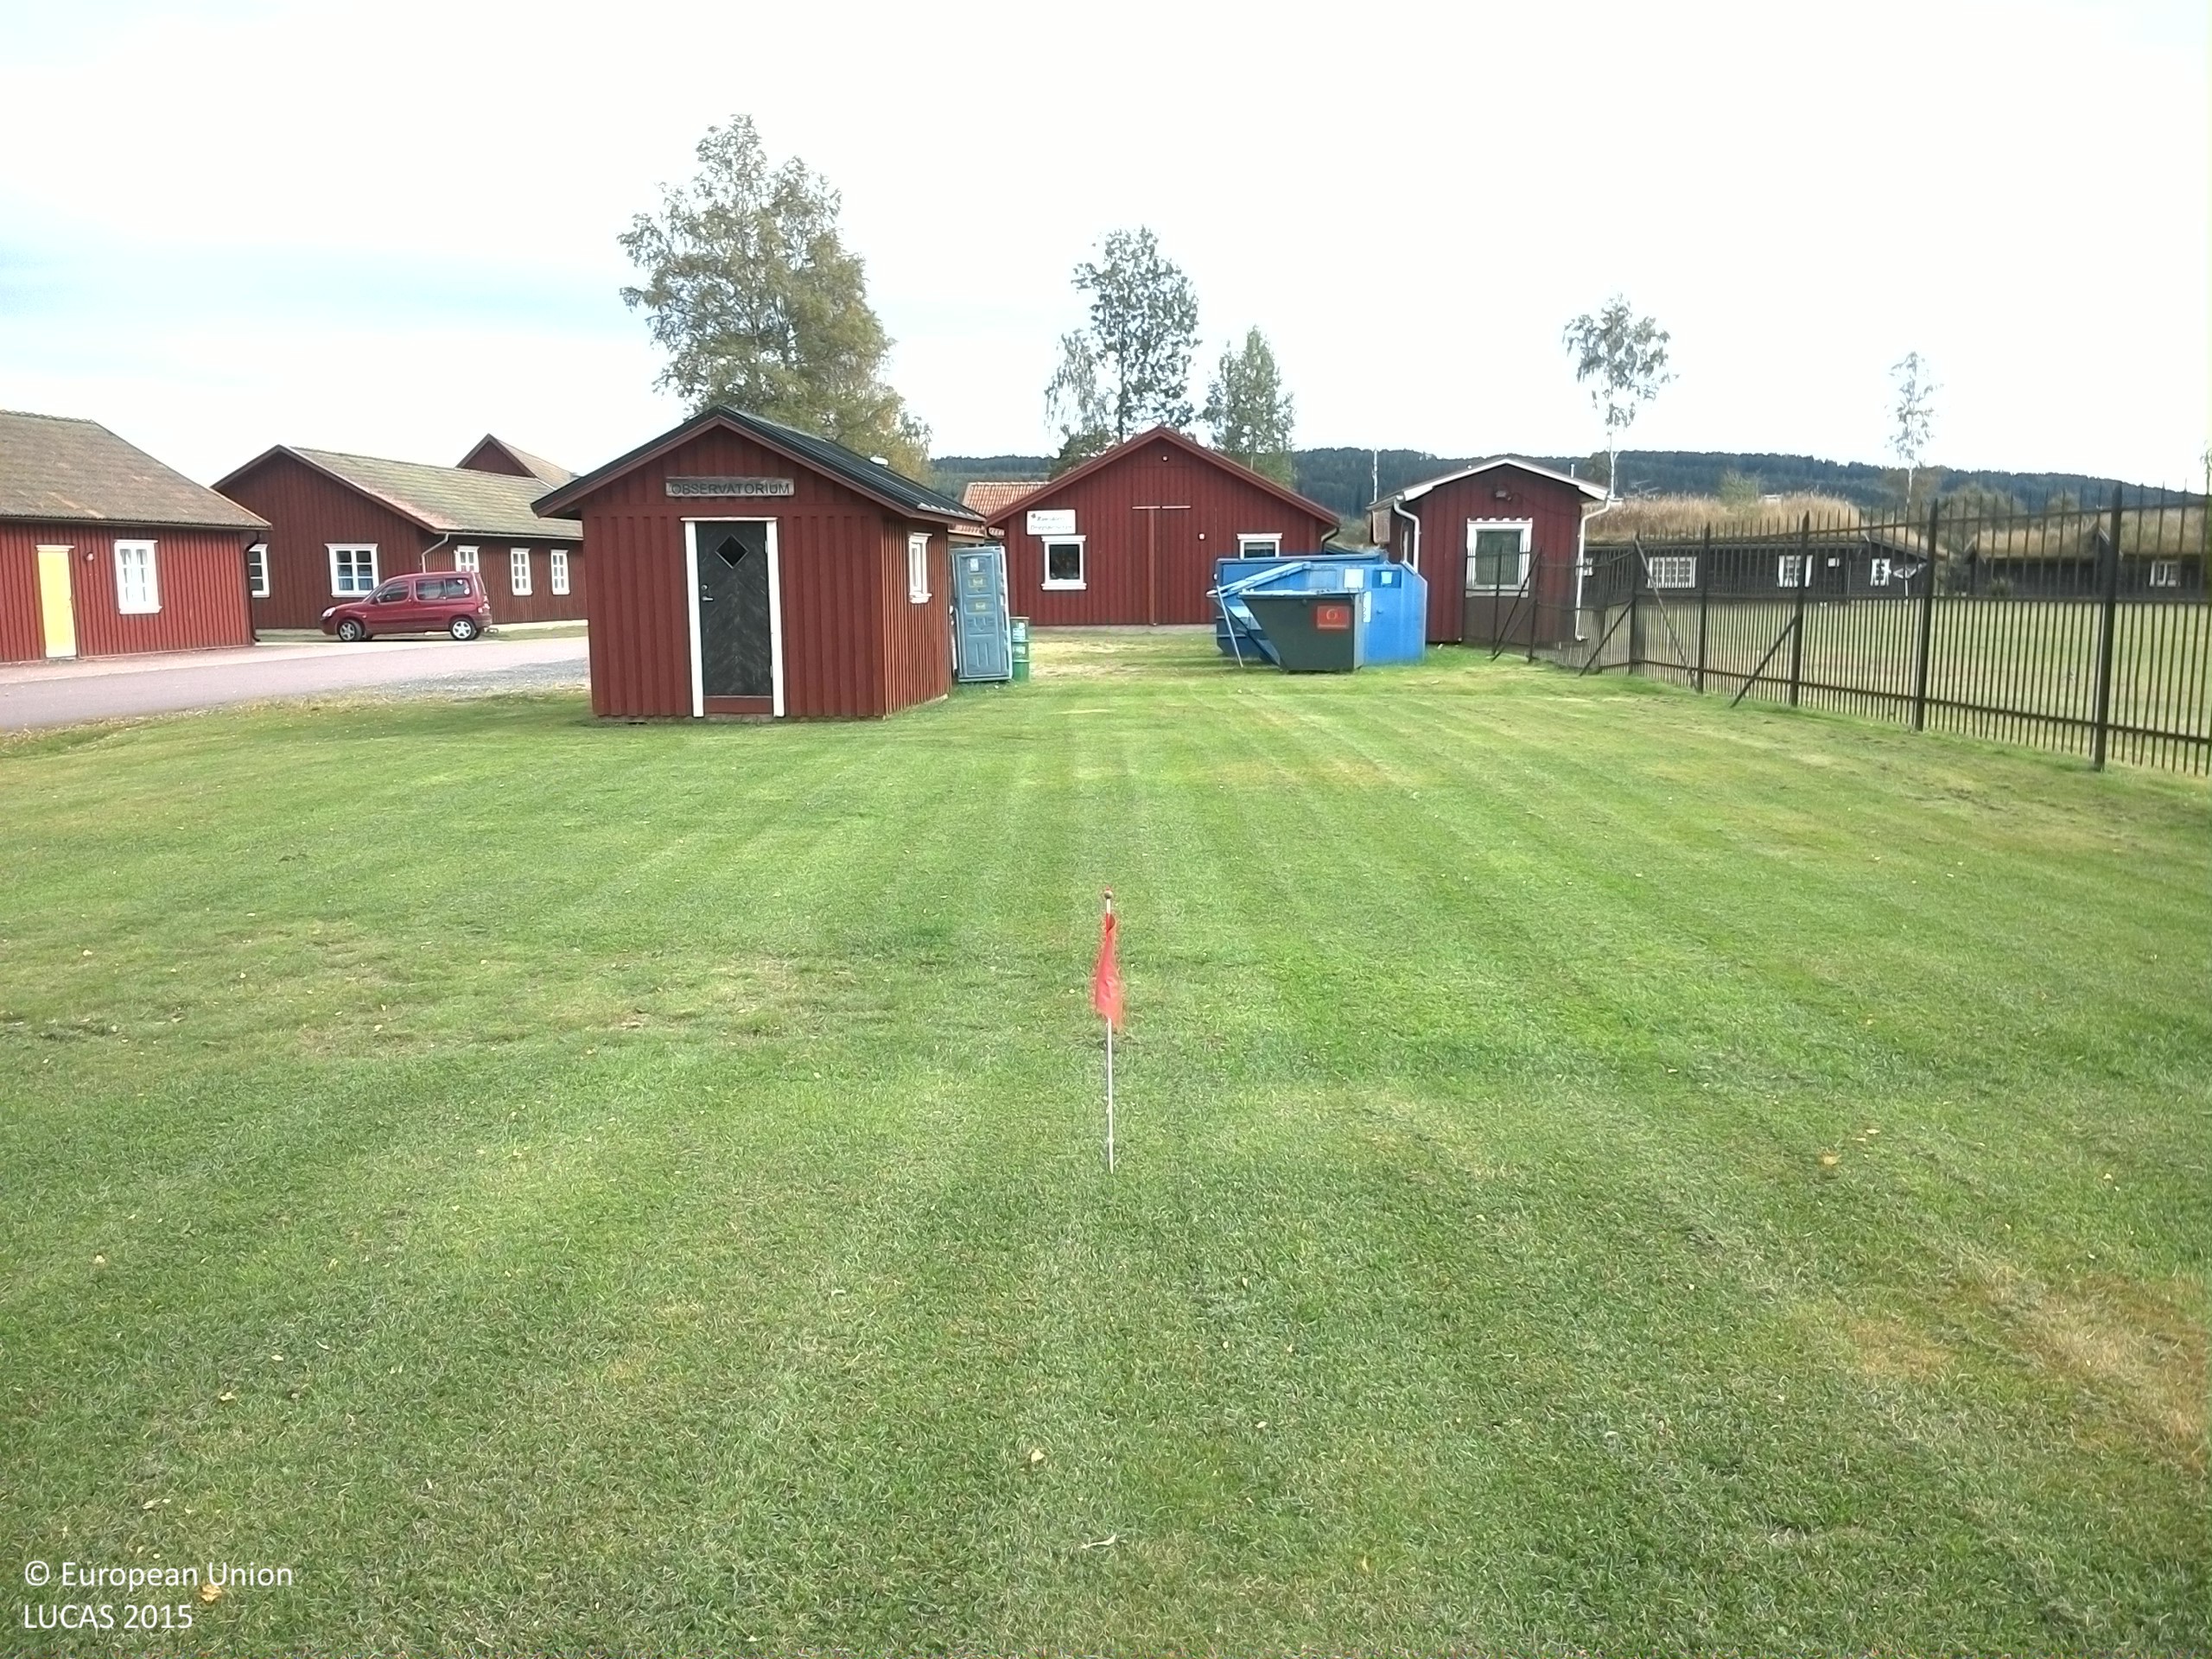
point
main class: Grassland
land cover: Grassland without tree/shrub cover
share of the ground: > 75 %
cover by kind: herbaceous plants 95 %, consolidated bare surface 5 %
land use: Amenities, museums, leisure
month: September
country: SE
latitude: 59.7778
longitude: 13.4645
